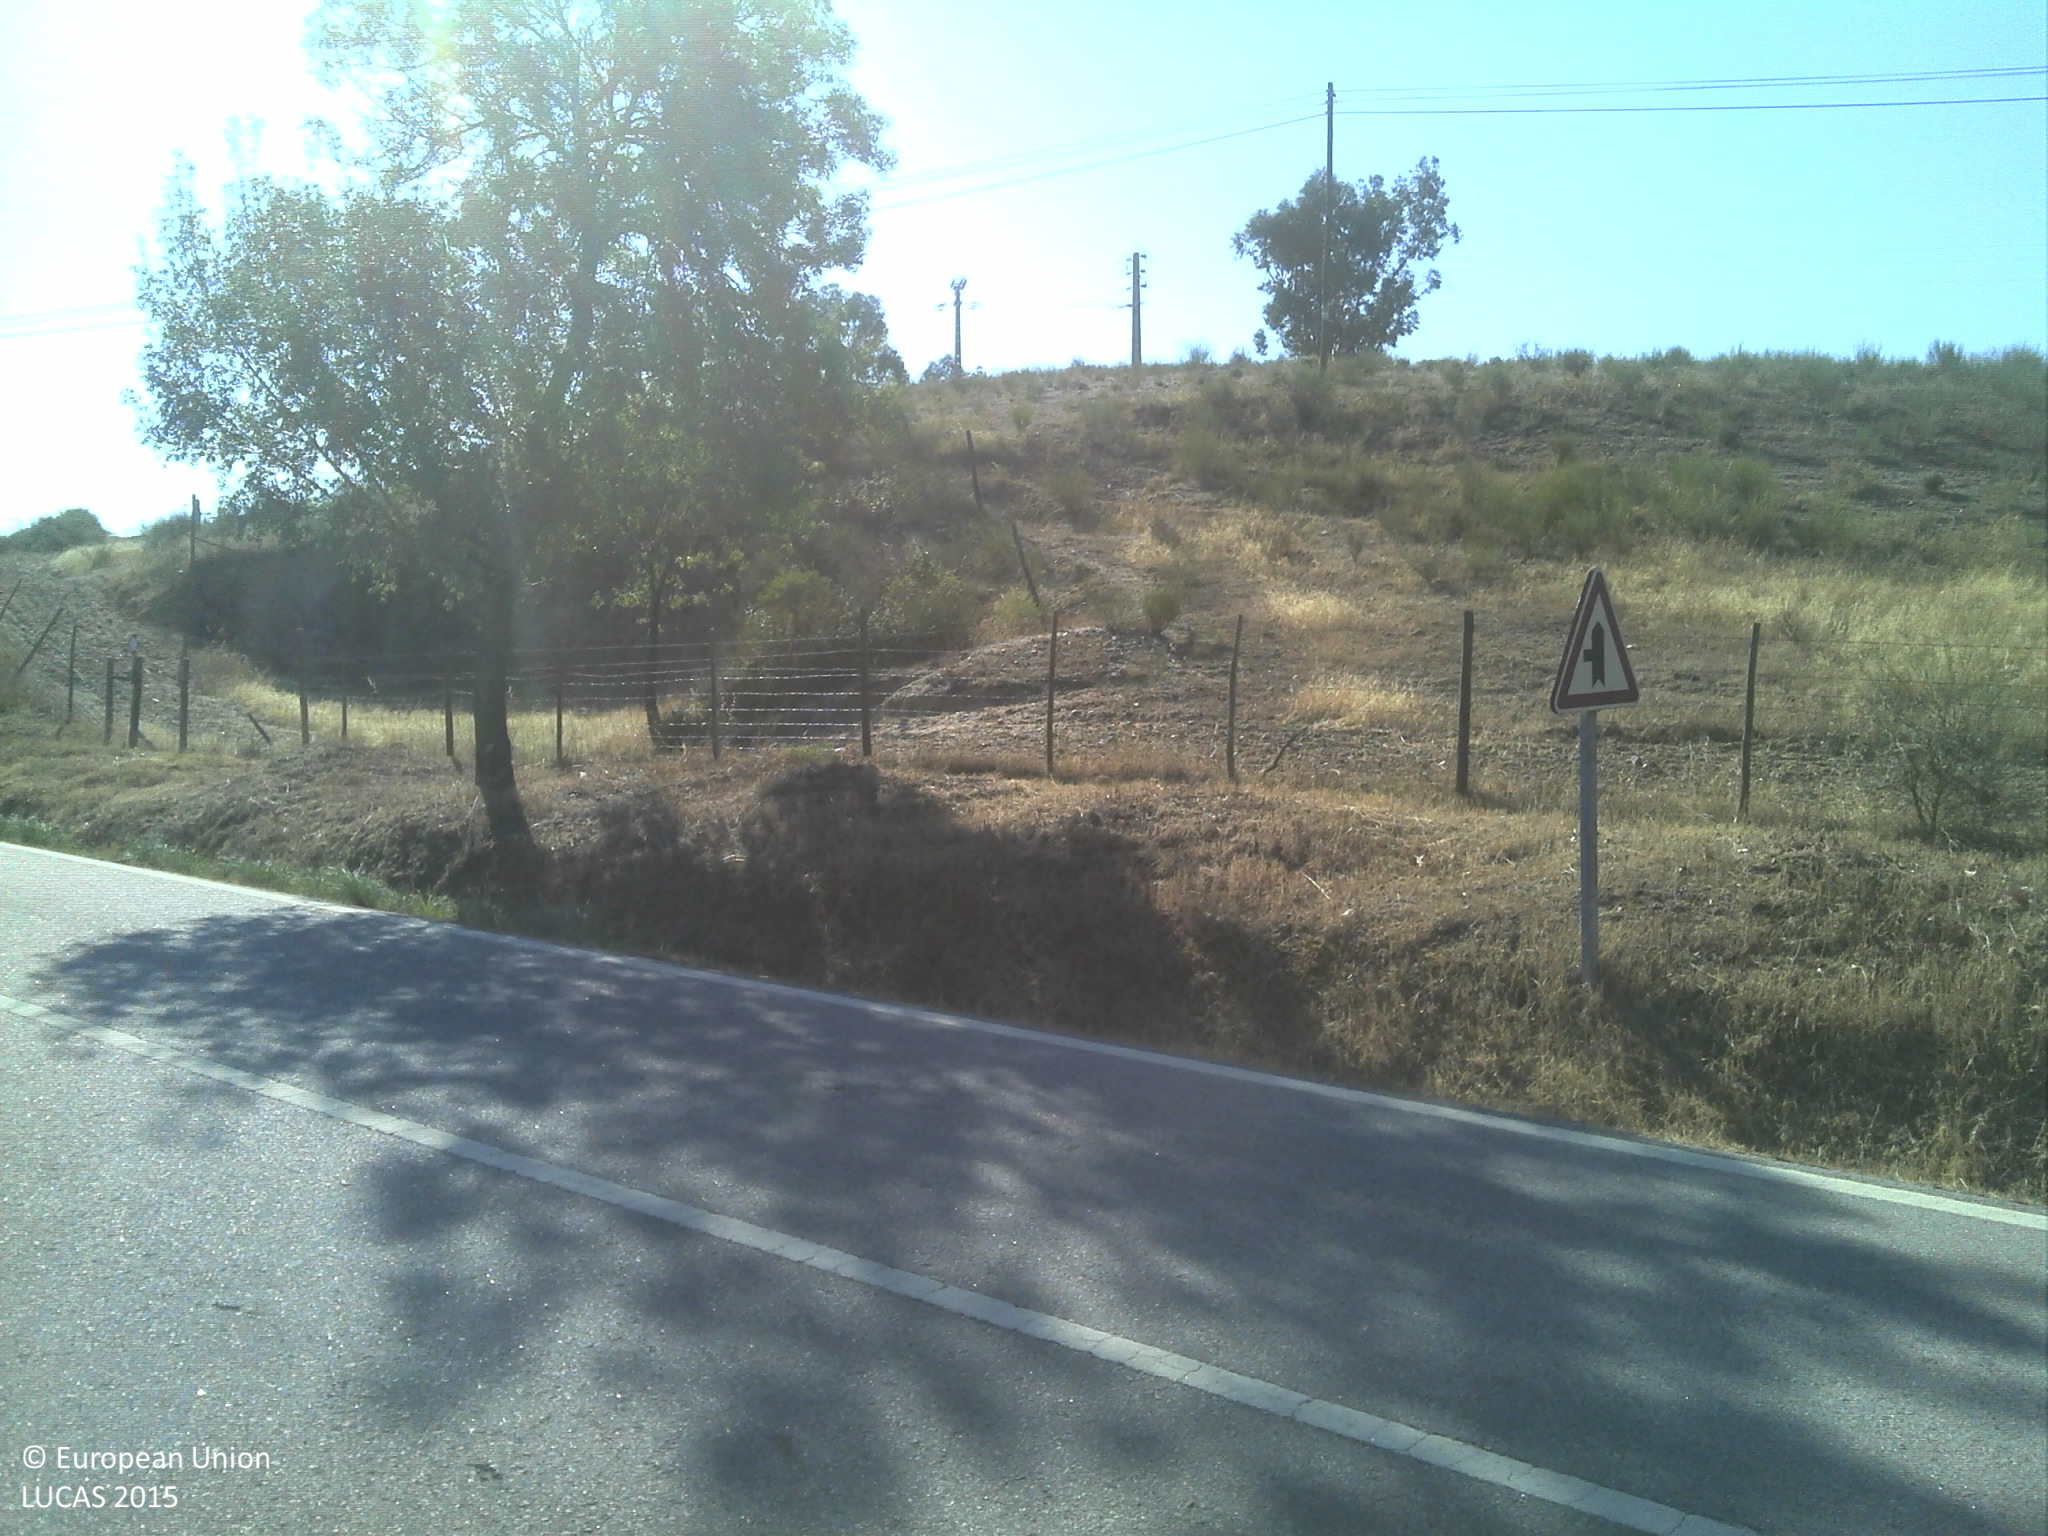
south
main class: Grassland
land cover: Grassland with sparse tree/shrub cover
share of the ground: 50 - 75 %
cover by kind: herbaceous plants 55 %, unconsolidated bare surface 30 %, broadleaved forest trees 5 %, shrubs 5 %
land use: Agriculture (excluding fallow land and kitchen gardens)
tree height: > 5 m
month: June
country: PT
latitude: 39.9104
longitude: -7.2319
